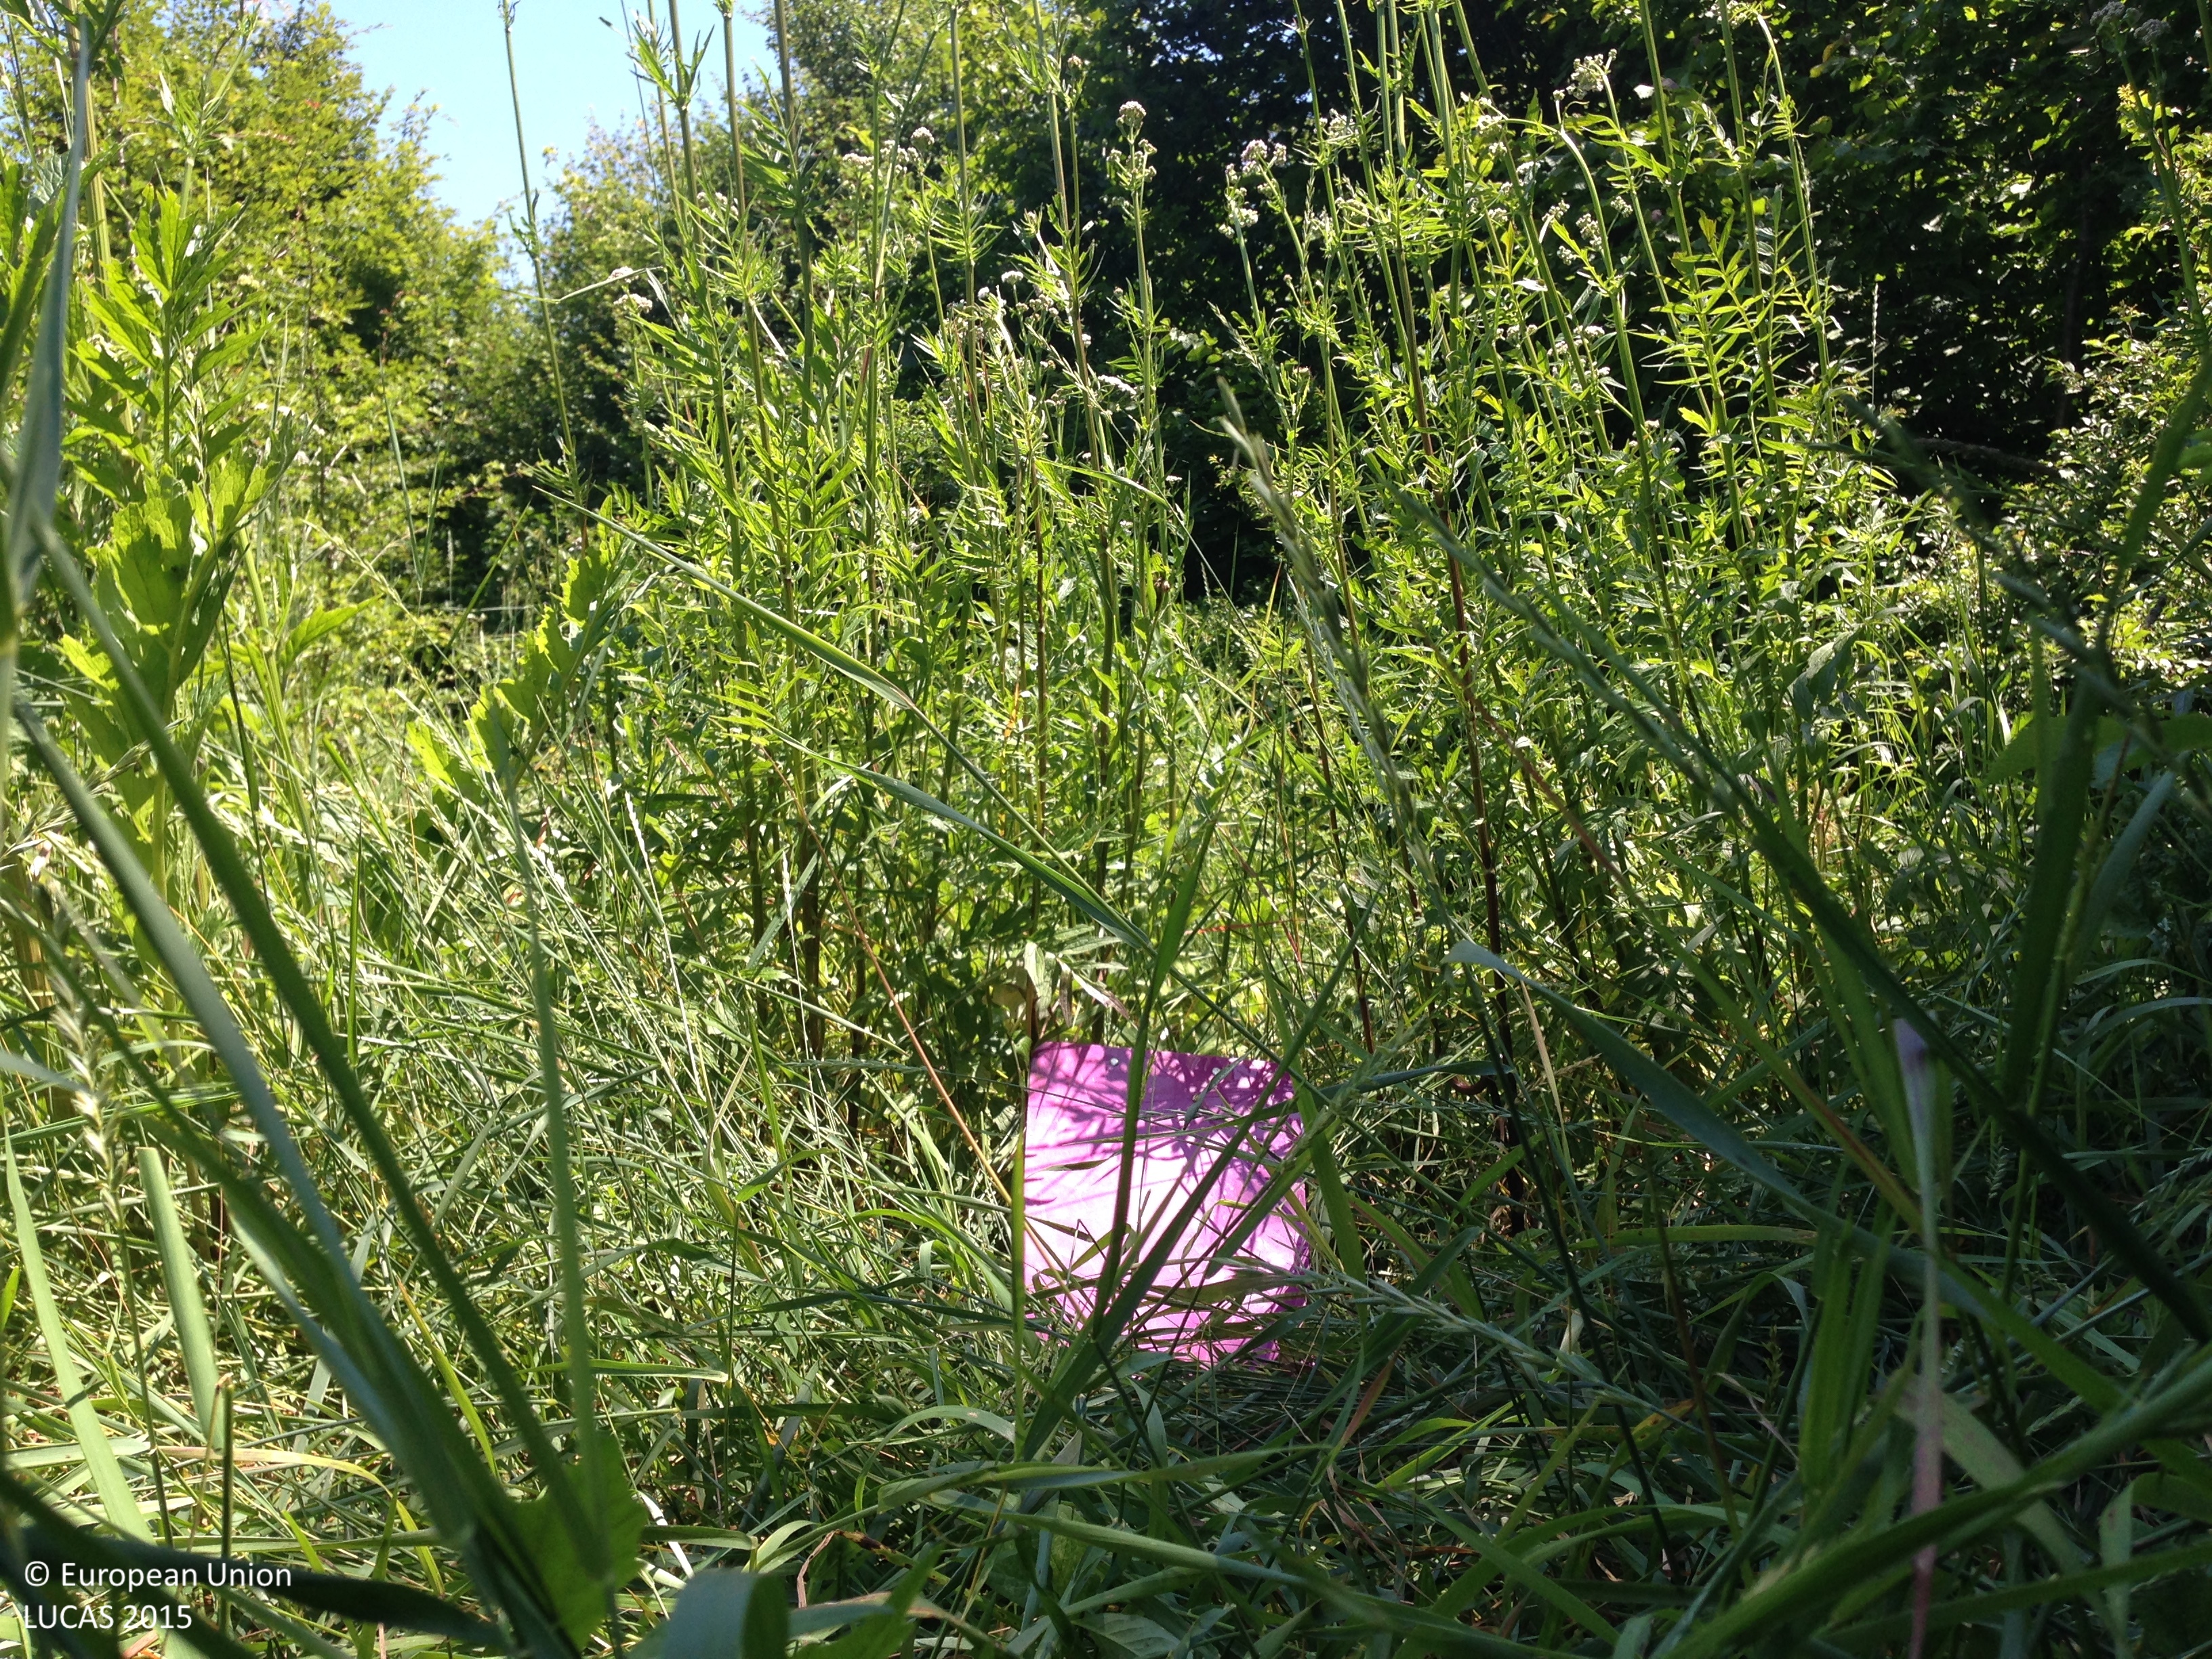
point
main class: Woodland
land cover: Broadleaved woodland
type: thermophilous deciduous forest
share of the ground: 25 - 50 %
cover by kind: herbaceous plants 40 %, broadleaved forest trees 30 %, shrubs 30 %
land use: Forestry
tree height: > 5 m
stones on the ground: < 10 %
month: July
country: HR
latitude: 44.5986
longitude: 15.2217
